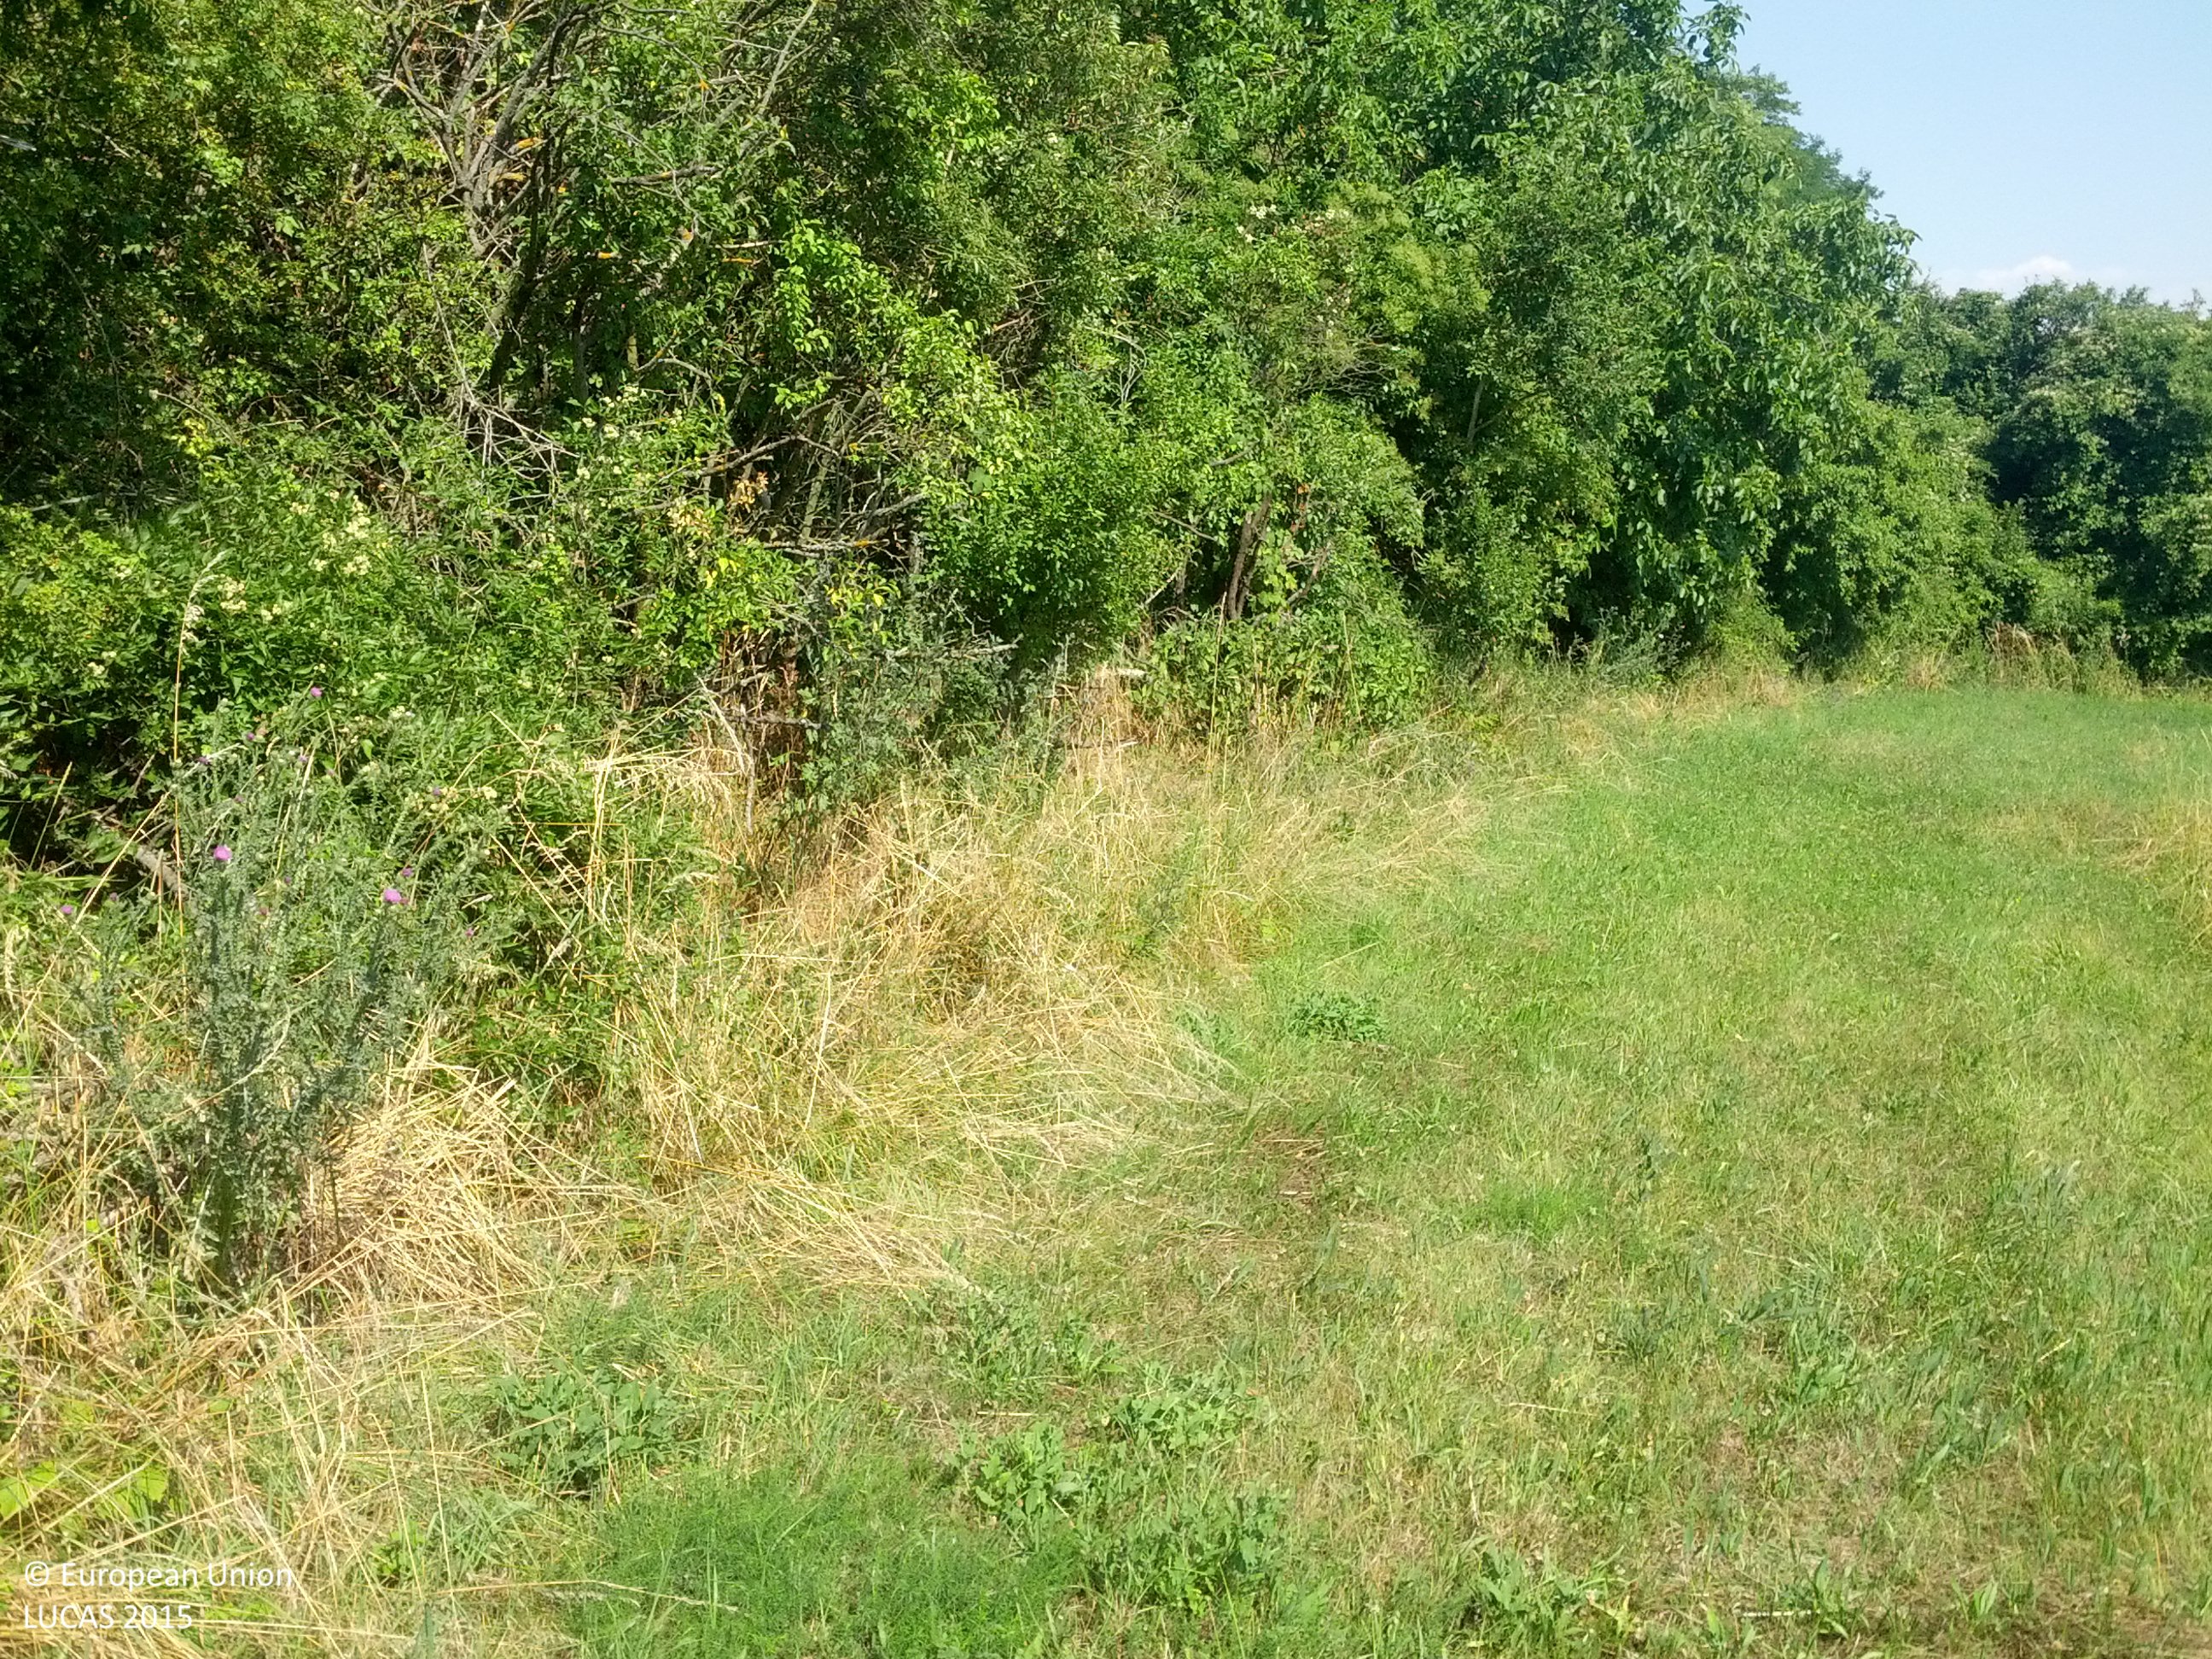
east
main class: Grassland
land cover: Grassland without tree/shrub cover
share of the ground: > 75 %
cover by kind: herbaceous plants 100 %
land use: Agriculture (excluding fallow land and kitchen gardens)
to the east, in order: Grassland without tree/shrub cover; Broadleaved woodland; Tracks; Abandoned hedges; Vineyards; Single bushes/trees; Shrubland without tree cover; Grassland without tree/shrub cover; Vineyards; Broadleaved woodland; Grassland without tree/shrub cover; Common wheat; Electric lines; Common wheat
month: July
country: AT
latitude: 48.5083
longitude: 16.6800
